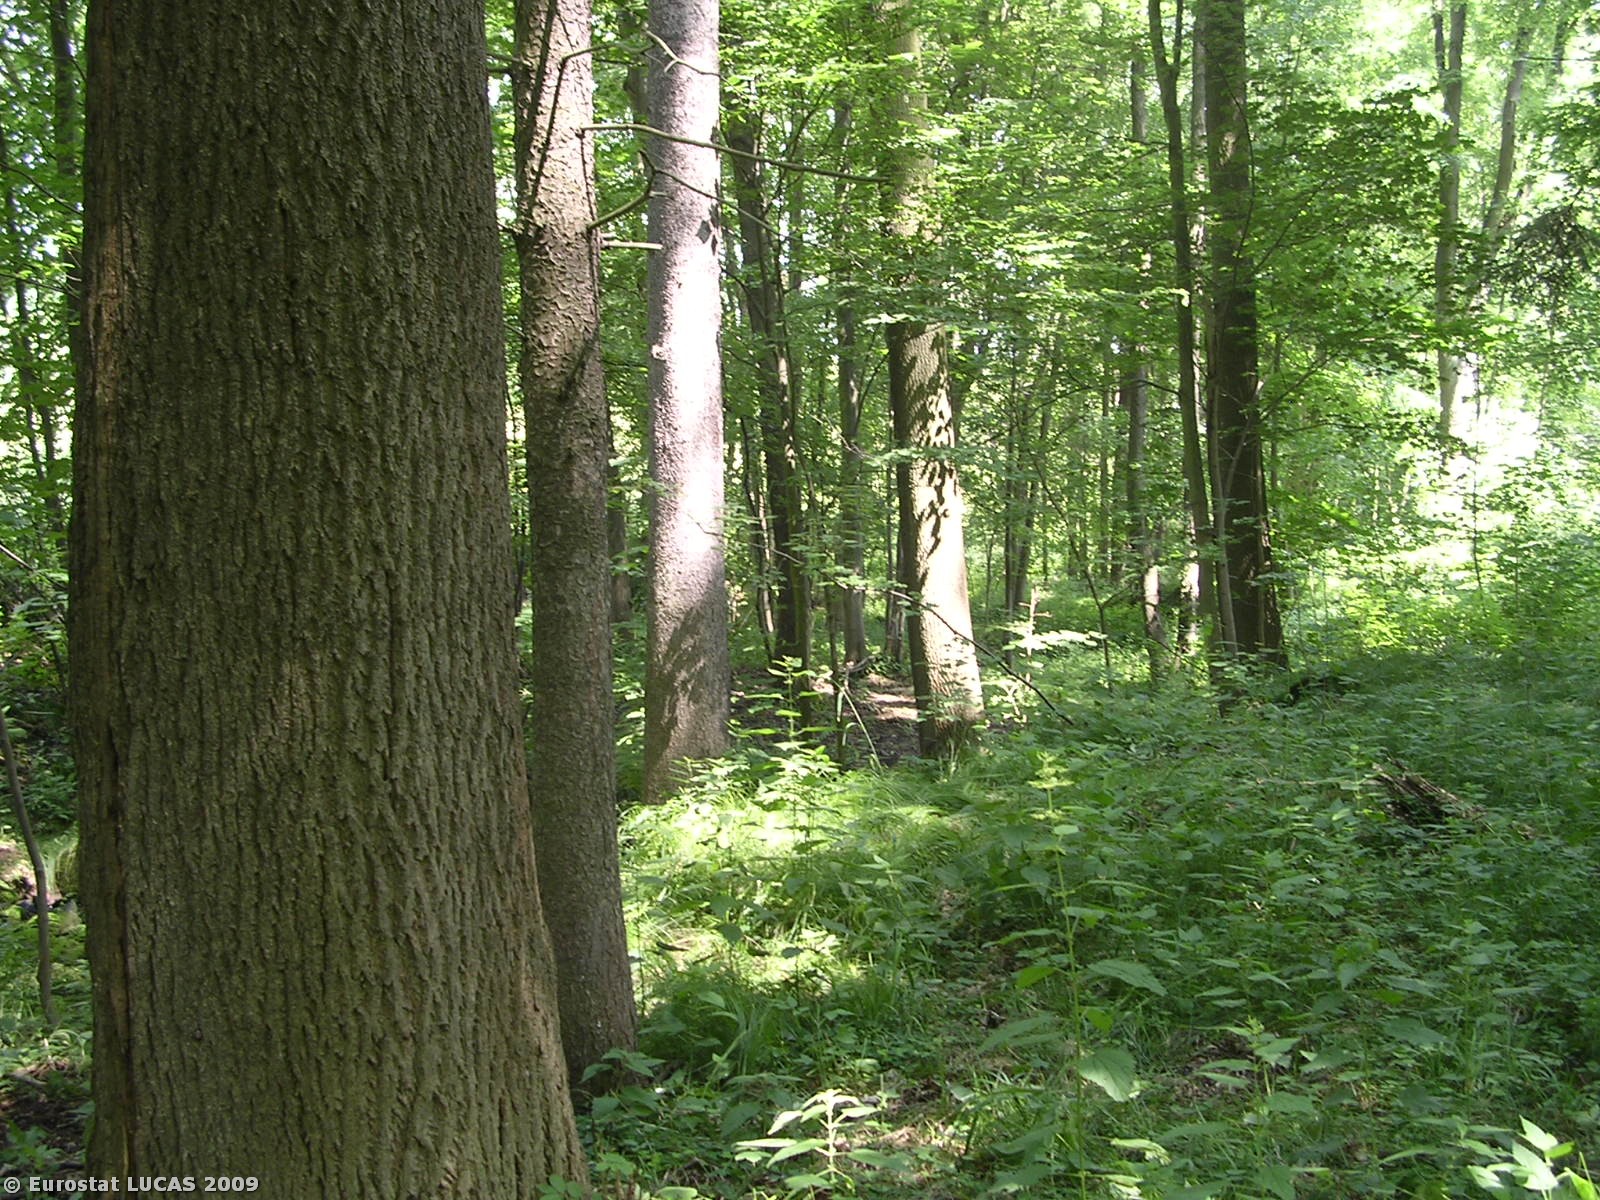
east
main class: Woodland
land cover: Broadleaved woodland
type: mesophytic deciduous forest
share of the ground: > 75 %
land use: Forestry
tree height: > 5 m
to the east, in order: Broadleaved woodland; Rivers and streams; Broadleaved woodland; Electric lines; Broadleaved woodland; Tracks; Broadleaved woodland; Fences; Grassland without tree/shrub cover
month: June
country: CZ
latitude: 50.7167
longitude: 14.2646
